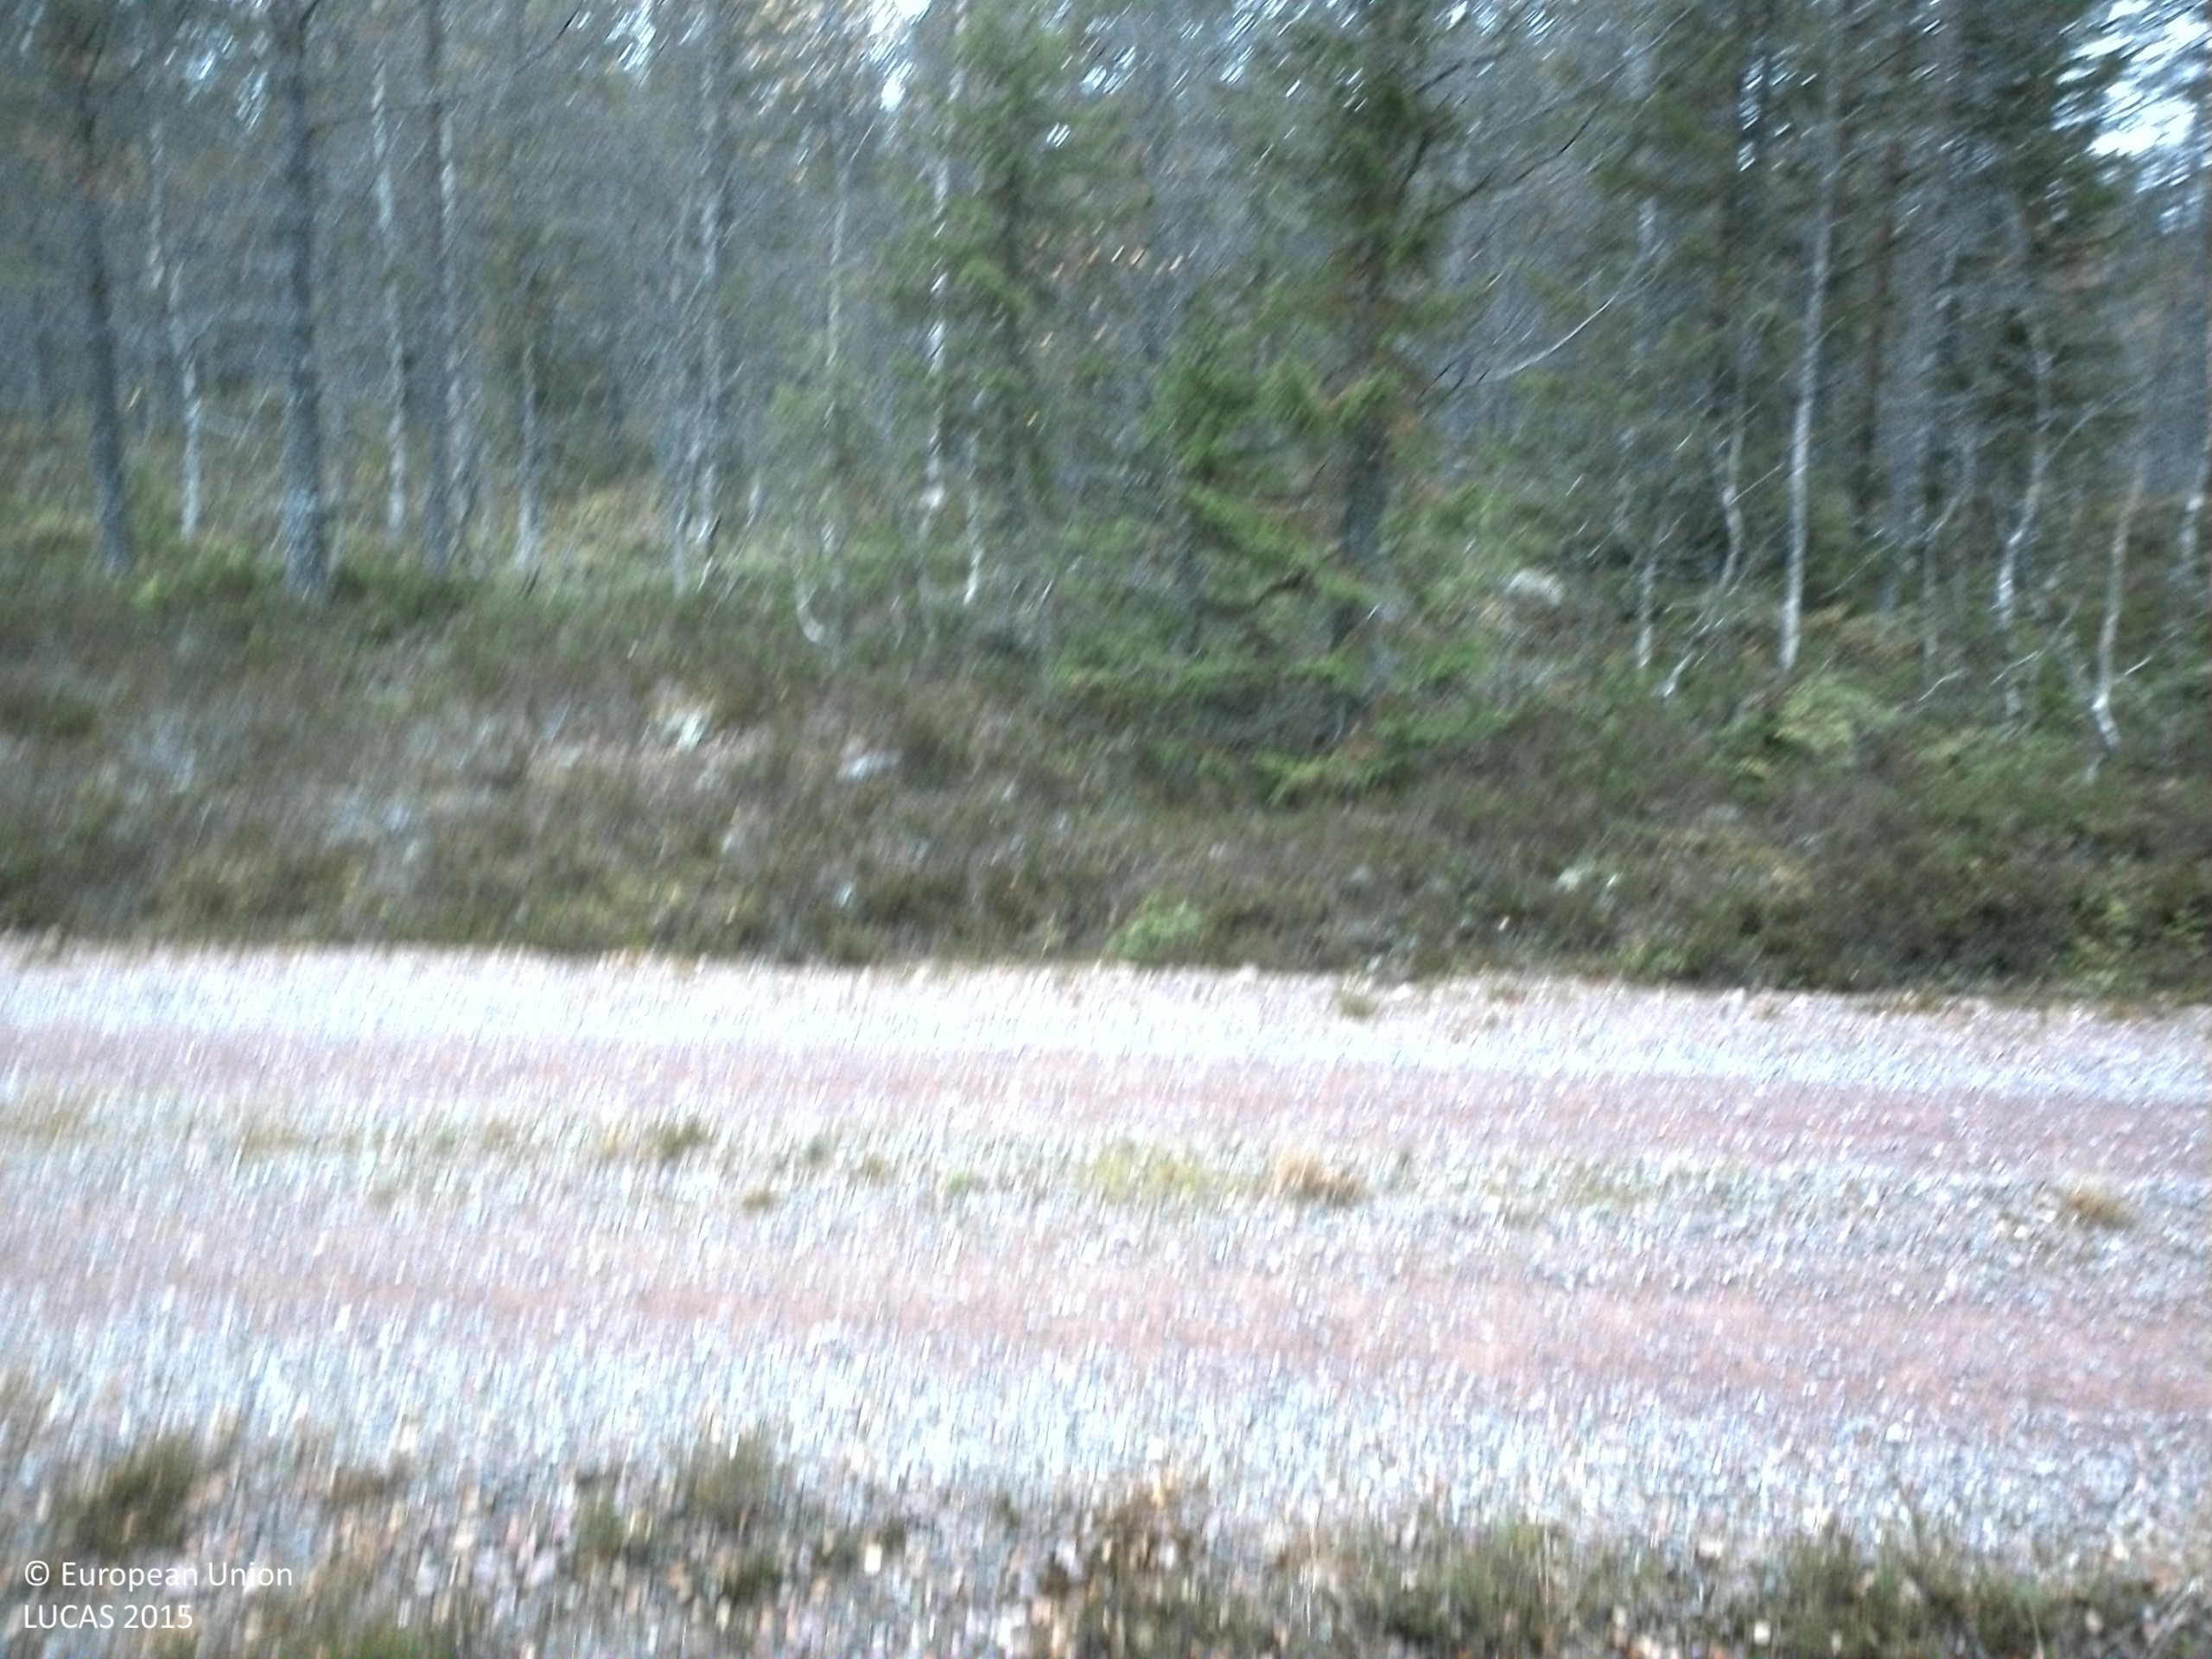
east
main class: Woodland
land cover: Spruce dominated mixed woodland
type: boreal forest
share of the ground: 25 - 50 %
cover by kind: coniferous forest trees 30 %, shrubs 30 %, consolidated bare surface 25 %, broadleaved forest trees 15 %
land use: Forestry
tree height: > 5 m
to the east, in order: Spruce dominated mixed woodland; Paved roads, cycling and walking lanes; Other mixed woodland; Pine dominated coniferous woodland; Other mixed woodland; Pine dominated mixed woodland; Spruce dominated mixed woodland; Pine dominated mixed woodland; Other coniferous woodland; Pine dominated mixed woodland; Other mixed woodland
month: October
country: SE
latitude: 61.3246
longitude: 14.2642
